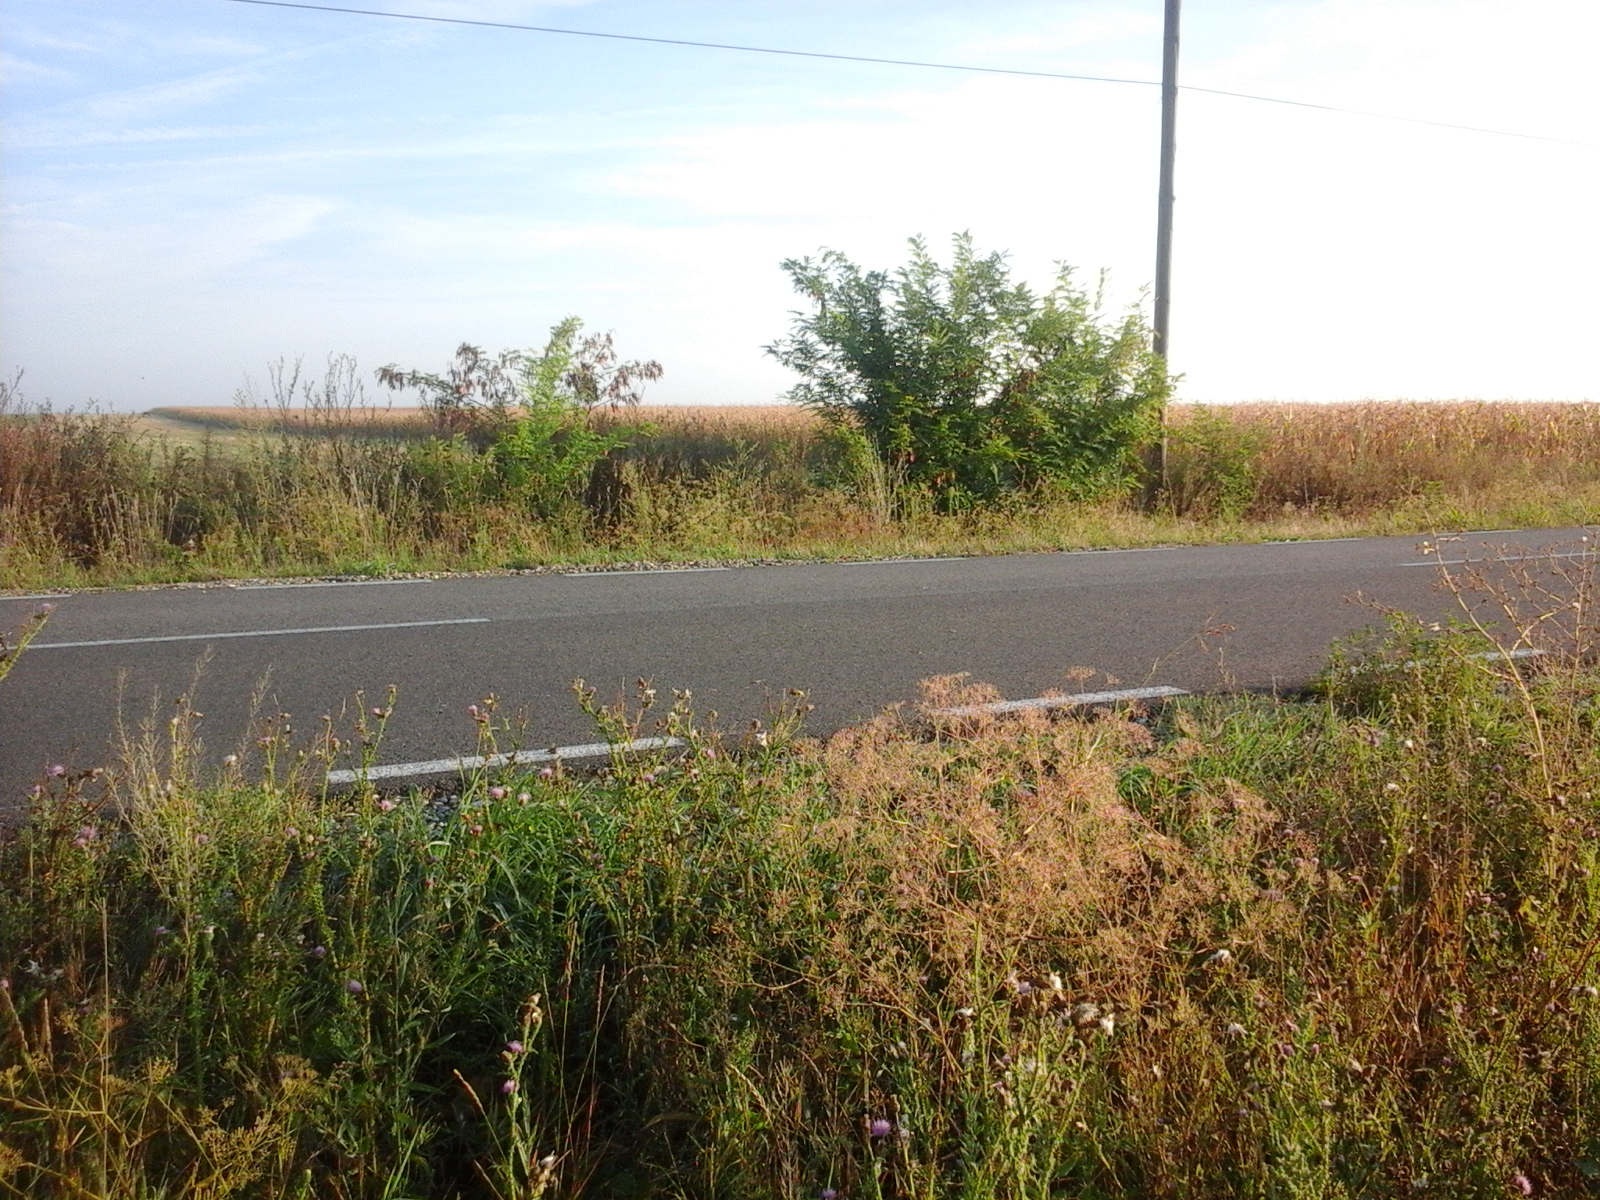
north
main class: Cropland
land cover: Maize
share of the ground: > 75 %
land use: Agriculture (excluding fallow land and kitchen gardens)
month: August
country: RO
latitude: 45.9547
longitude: 21.0870
